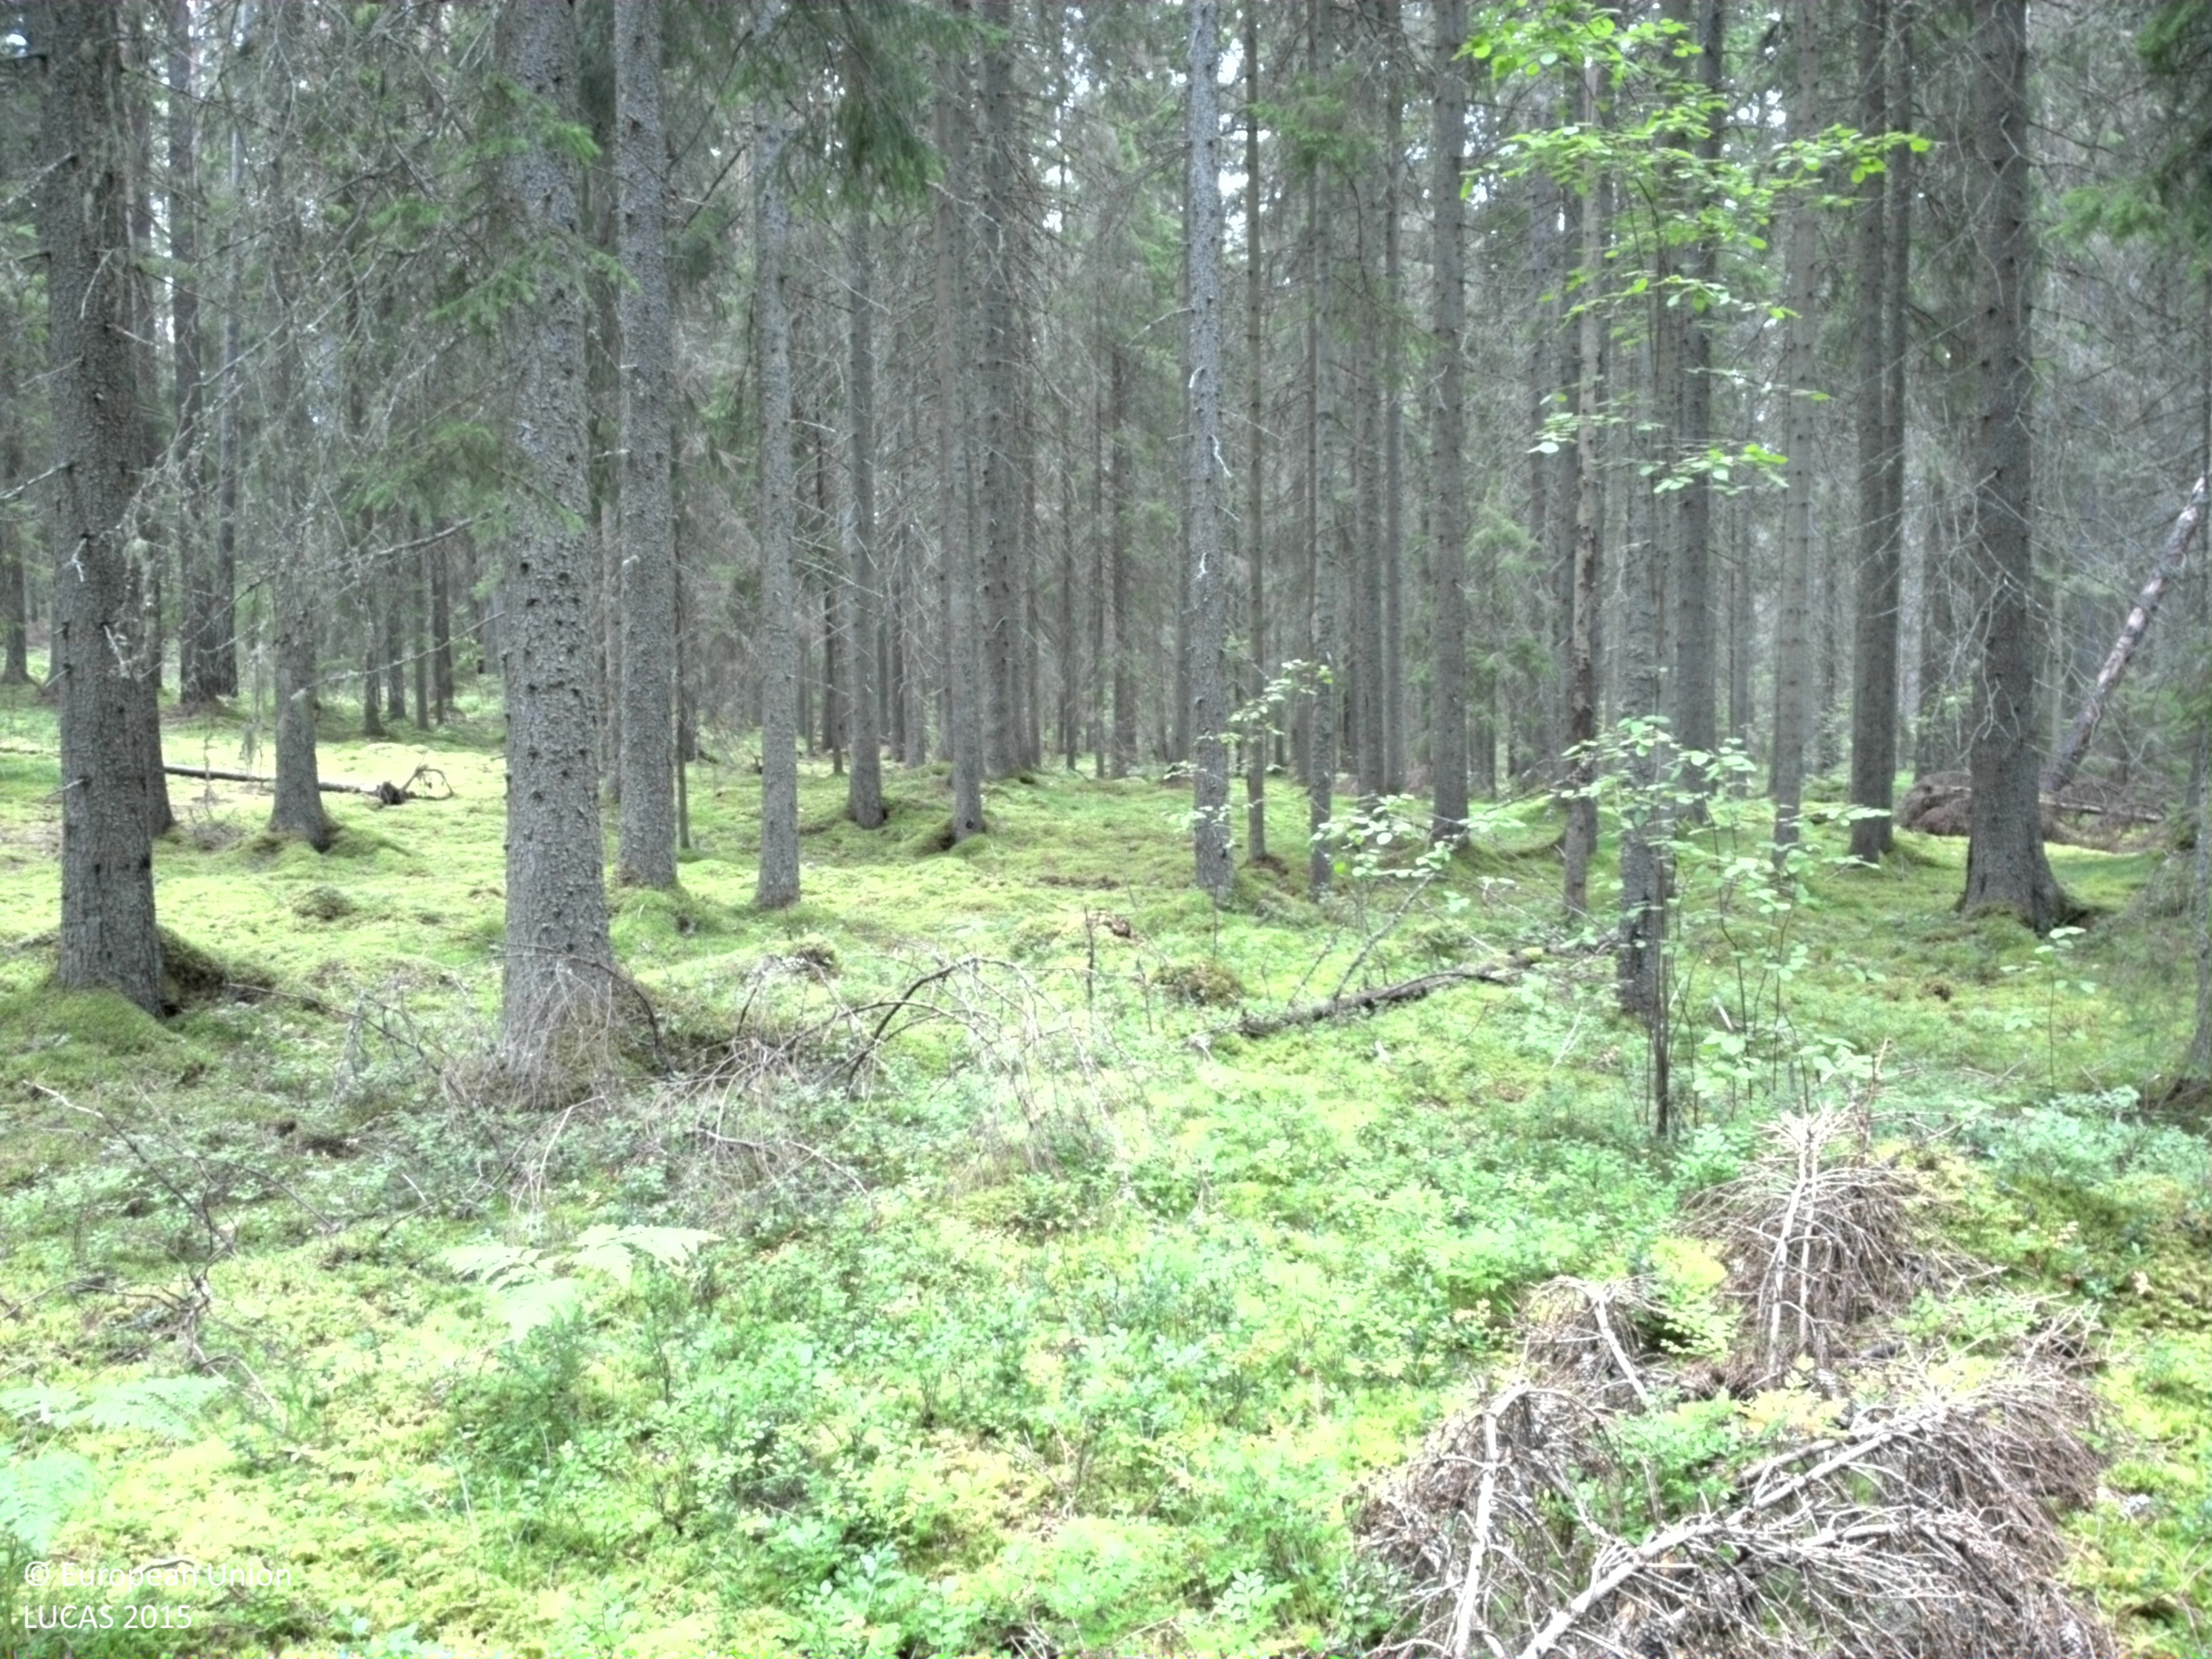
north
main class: Woodland
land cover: Spruce dominated coniferous woodland
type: boreal forest
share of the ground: > 75 %
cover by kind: coniferous forest trees 80 %, lichens and mosses 10 %, broadleaved forest trees 5 %, shrubs 5 %
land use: Forestry
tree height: > 5 m
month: August
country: SE
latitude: 59.8890
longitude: 16.4421
